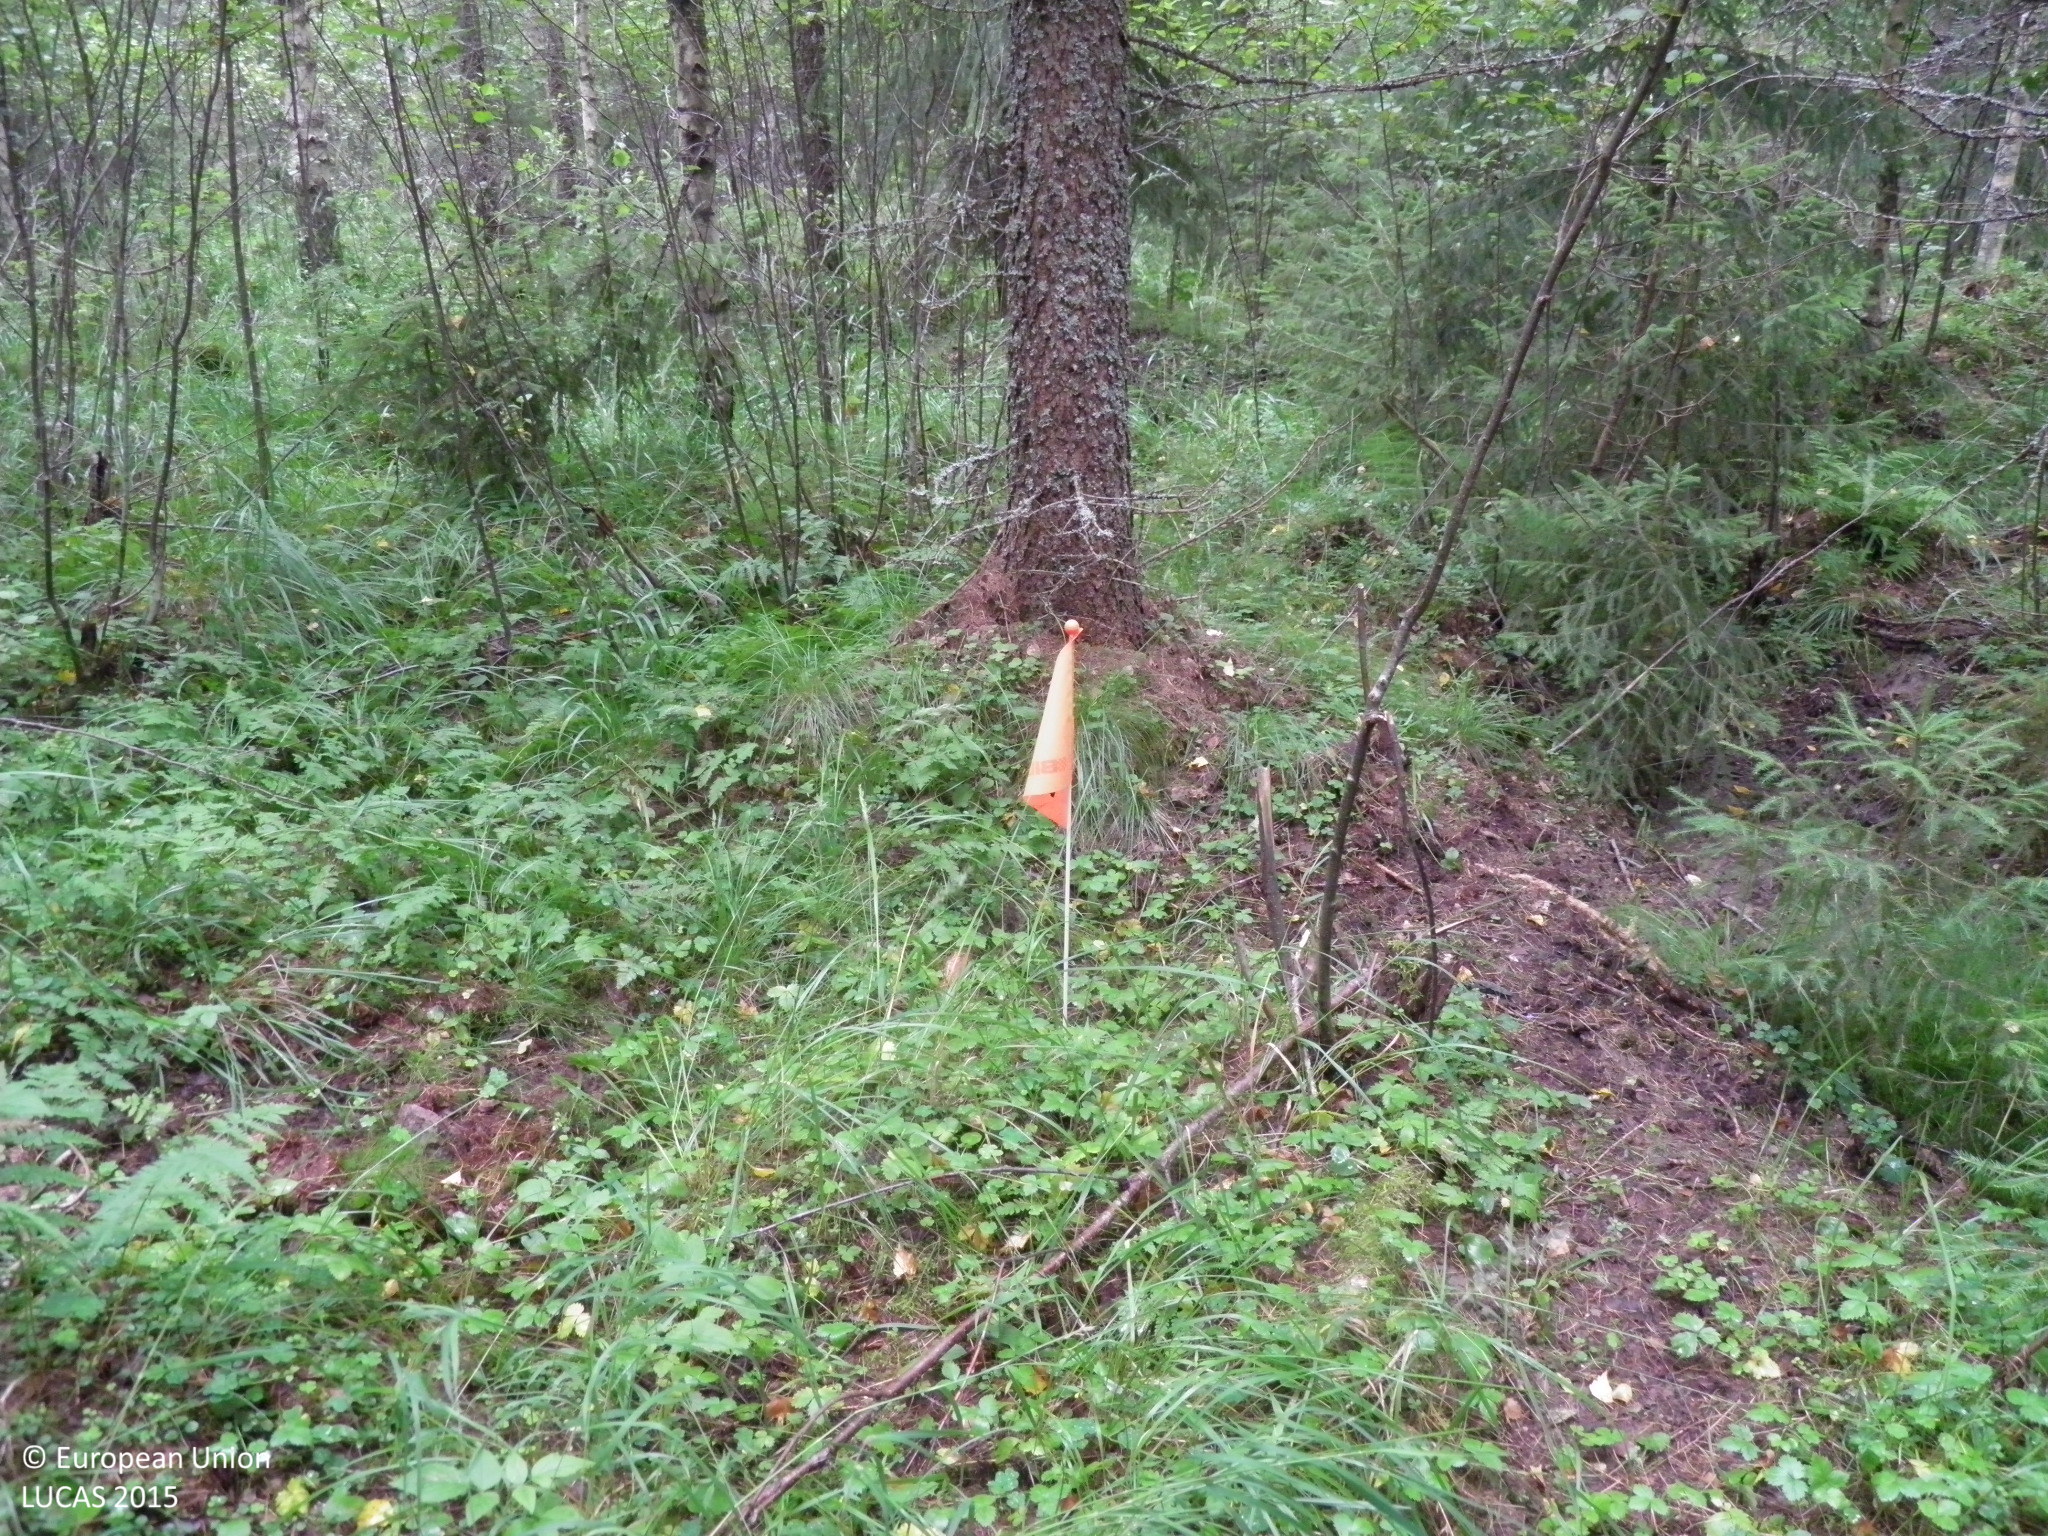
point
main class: Woodland
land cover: Pine dominated mixed woodland
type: hemiboreal forest and nemoral coniferous forest and mixed broadleaved-coniferous forest
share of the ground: > 75 %
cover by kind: broadleaved forest trees 45 %, coniferous forest trees 40 %, shrubs 5 %, herbaceous plants 5 %, lichens and mosses 5 %
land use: Forestry
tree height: > 5 m
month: July
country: FI
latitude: 60.8642
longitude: 22.9075
